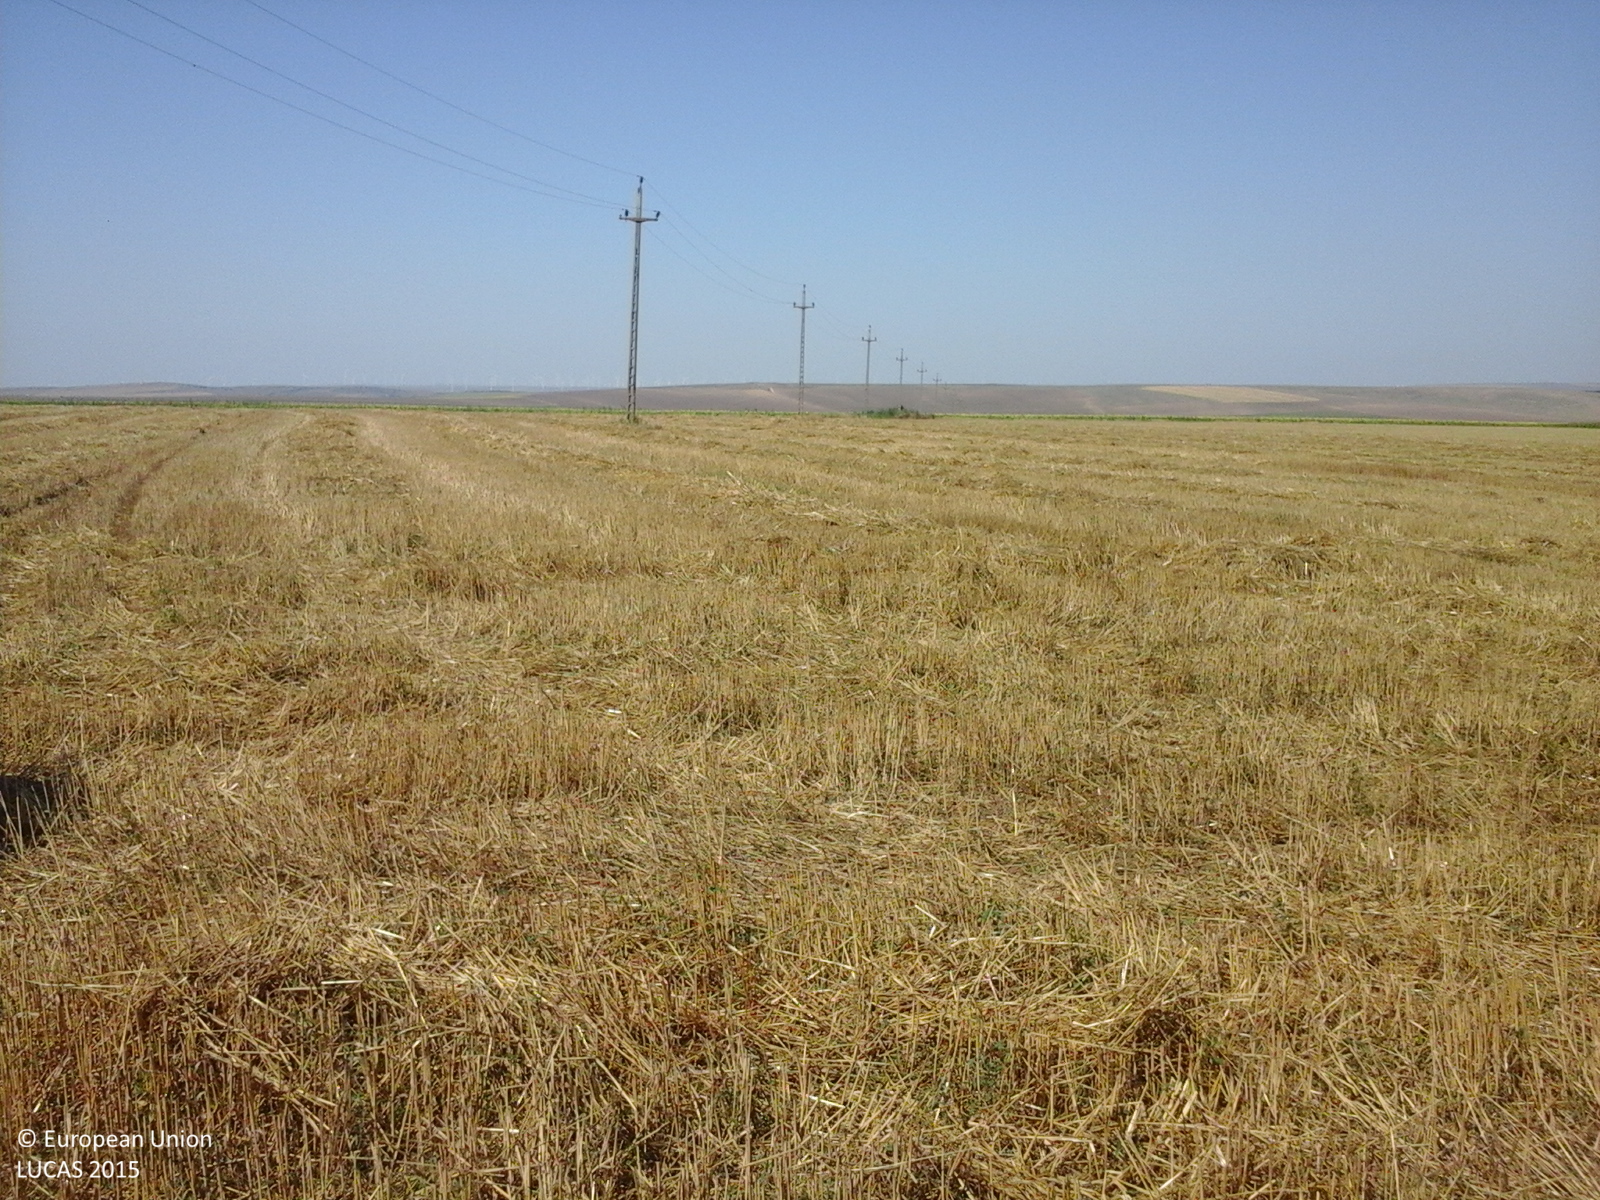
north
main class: Cropland
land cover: Common wheat
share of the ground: 25 - 50 %
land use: Agriculture (excluding fallow land and kitchen gardens)
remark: Harvested field
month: August
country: RO
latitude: 44.4108
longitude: 28.4684
